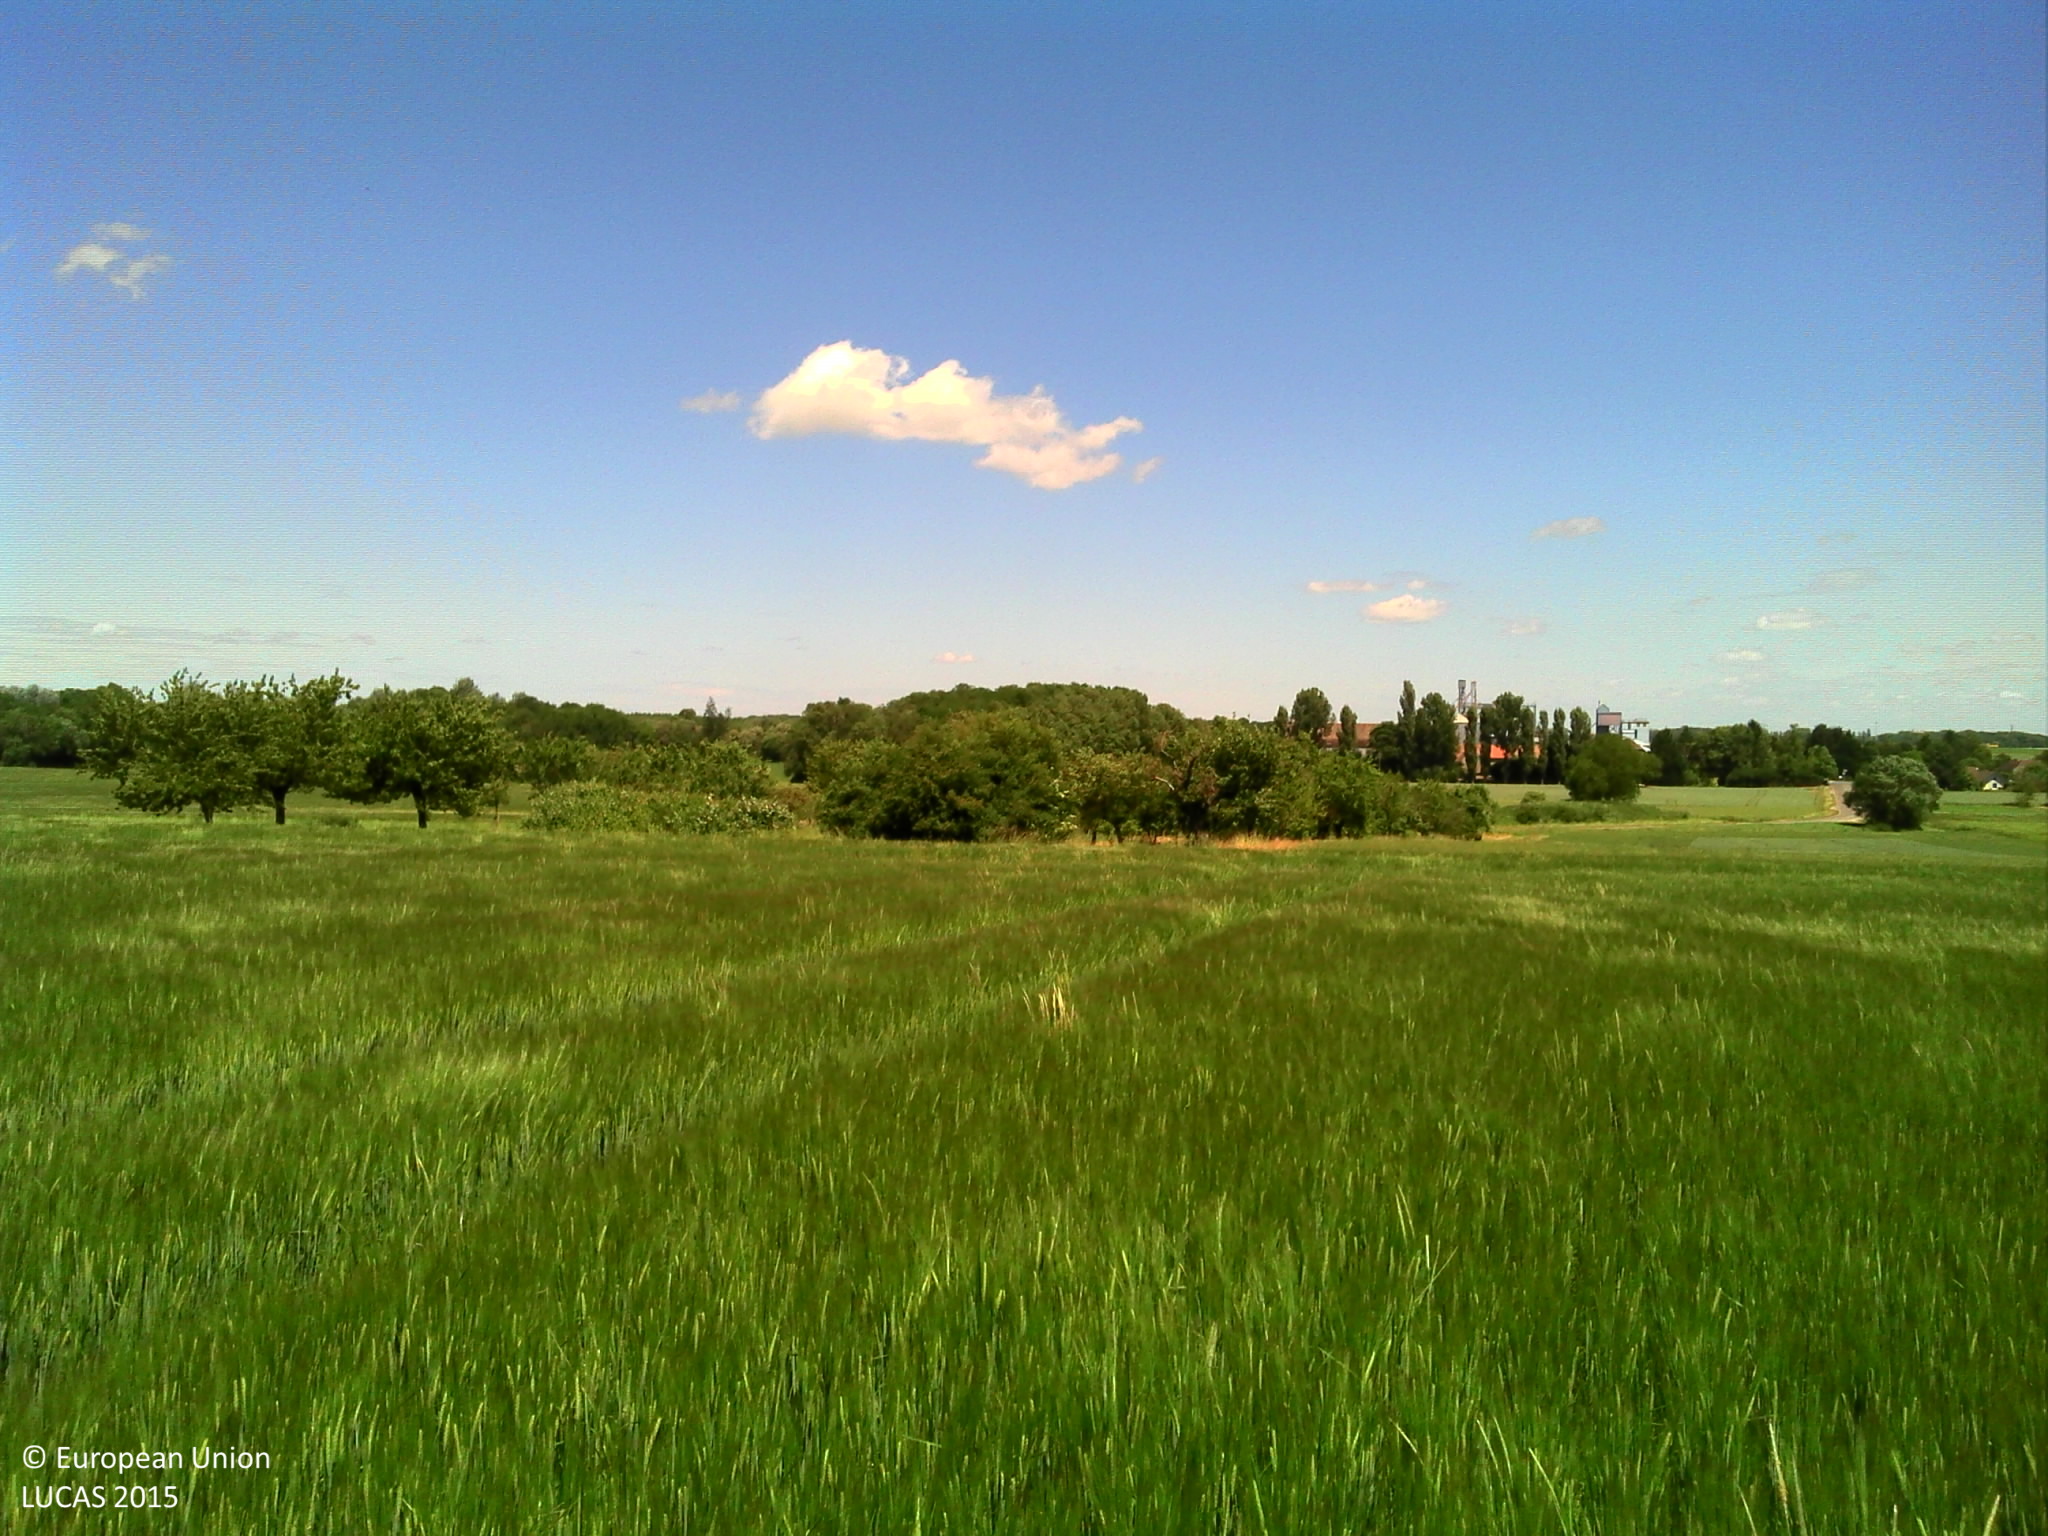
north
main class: Cropland
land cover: Barley
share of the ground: > 75 %
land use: Agriculture (excluding fallow land and kitchen gardens)
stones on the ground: < 10 %
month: June
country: FR
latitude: 47.2120
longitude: 5.0759
